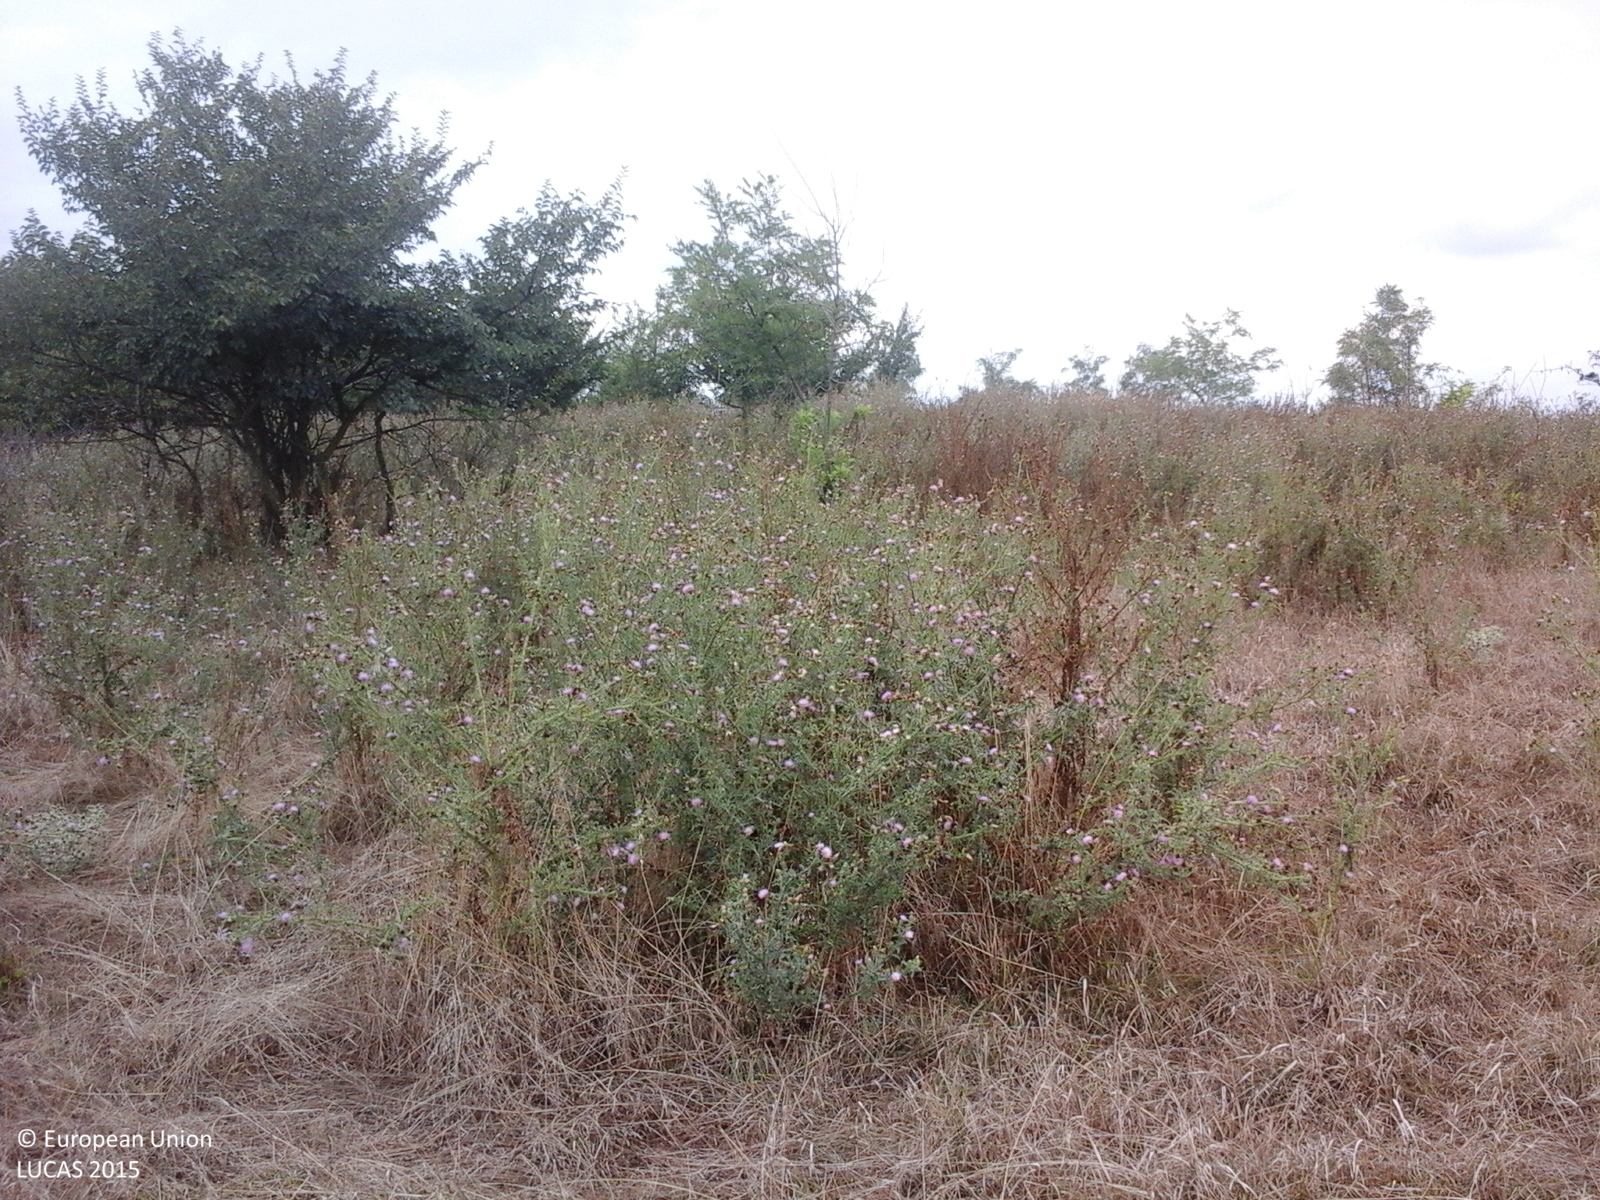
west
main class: Grassland
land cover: Spontaneously vegetated surfaces
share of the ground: > 75 %
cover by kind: herbaceous plants 100 %
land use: Semi-natural and natural areas not in use
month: August
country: RO
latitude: 46.0960
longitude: 20.4104
